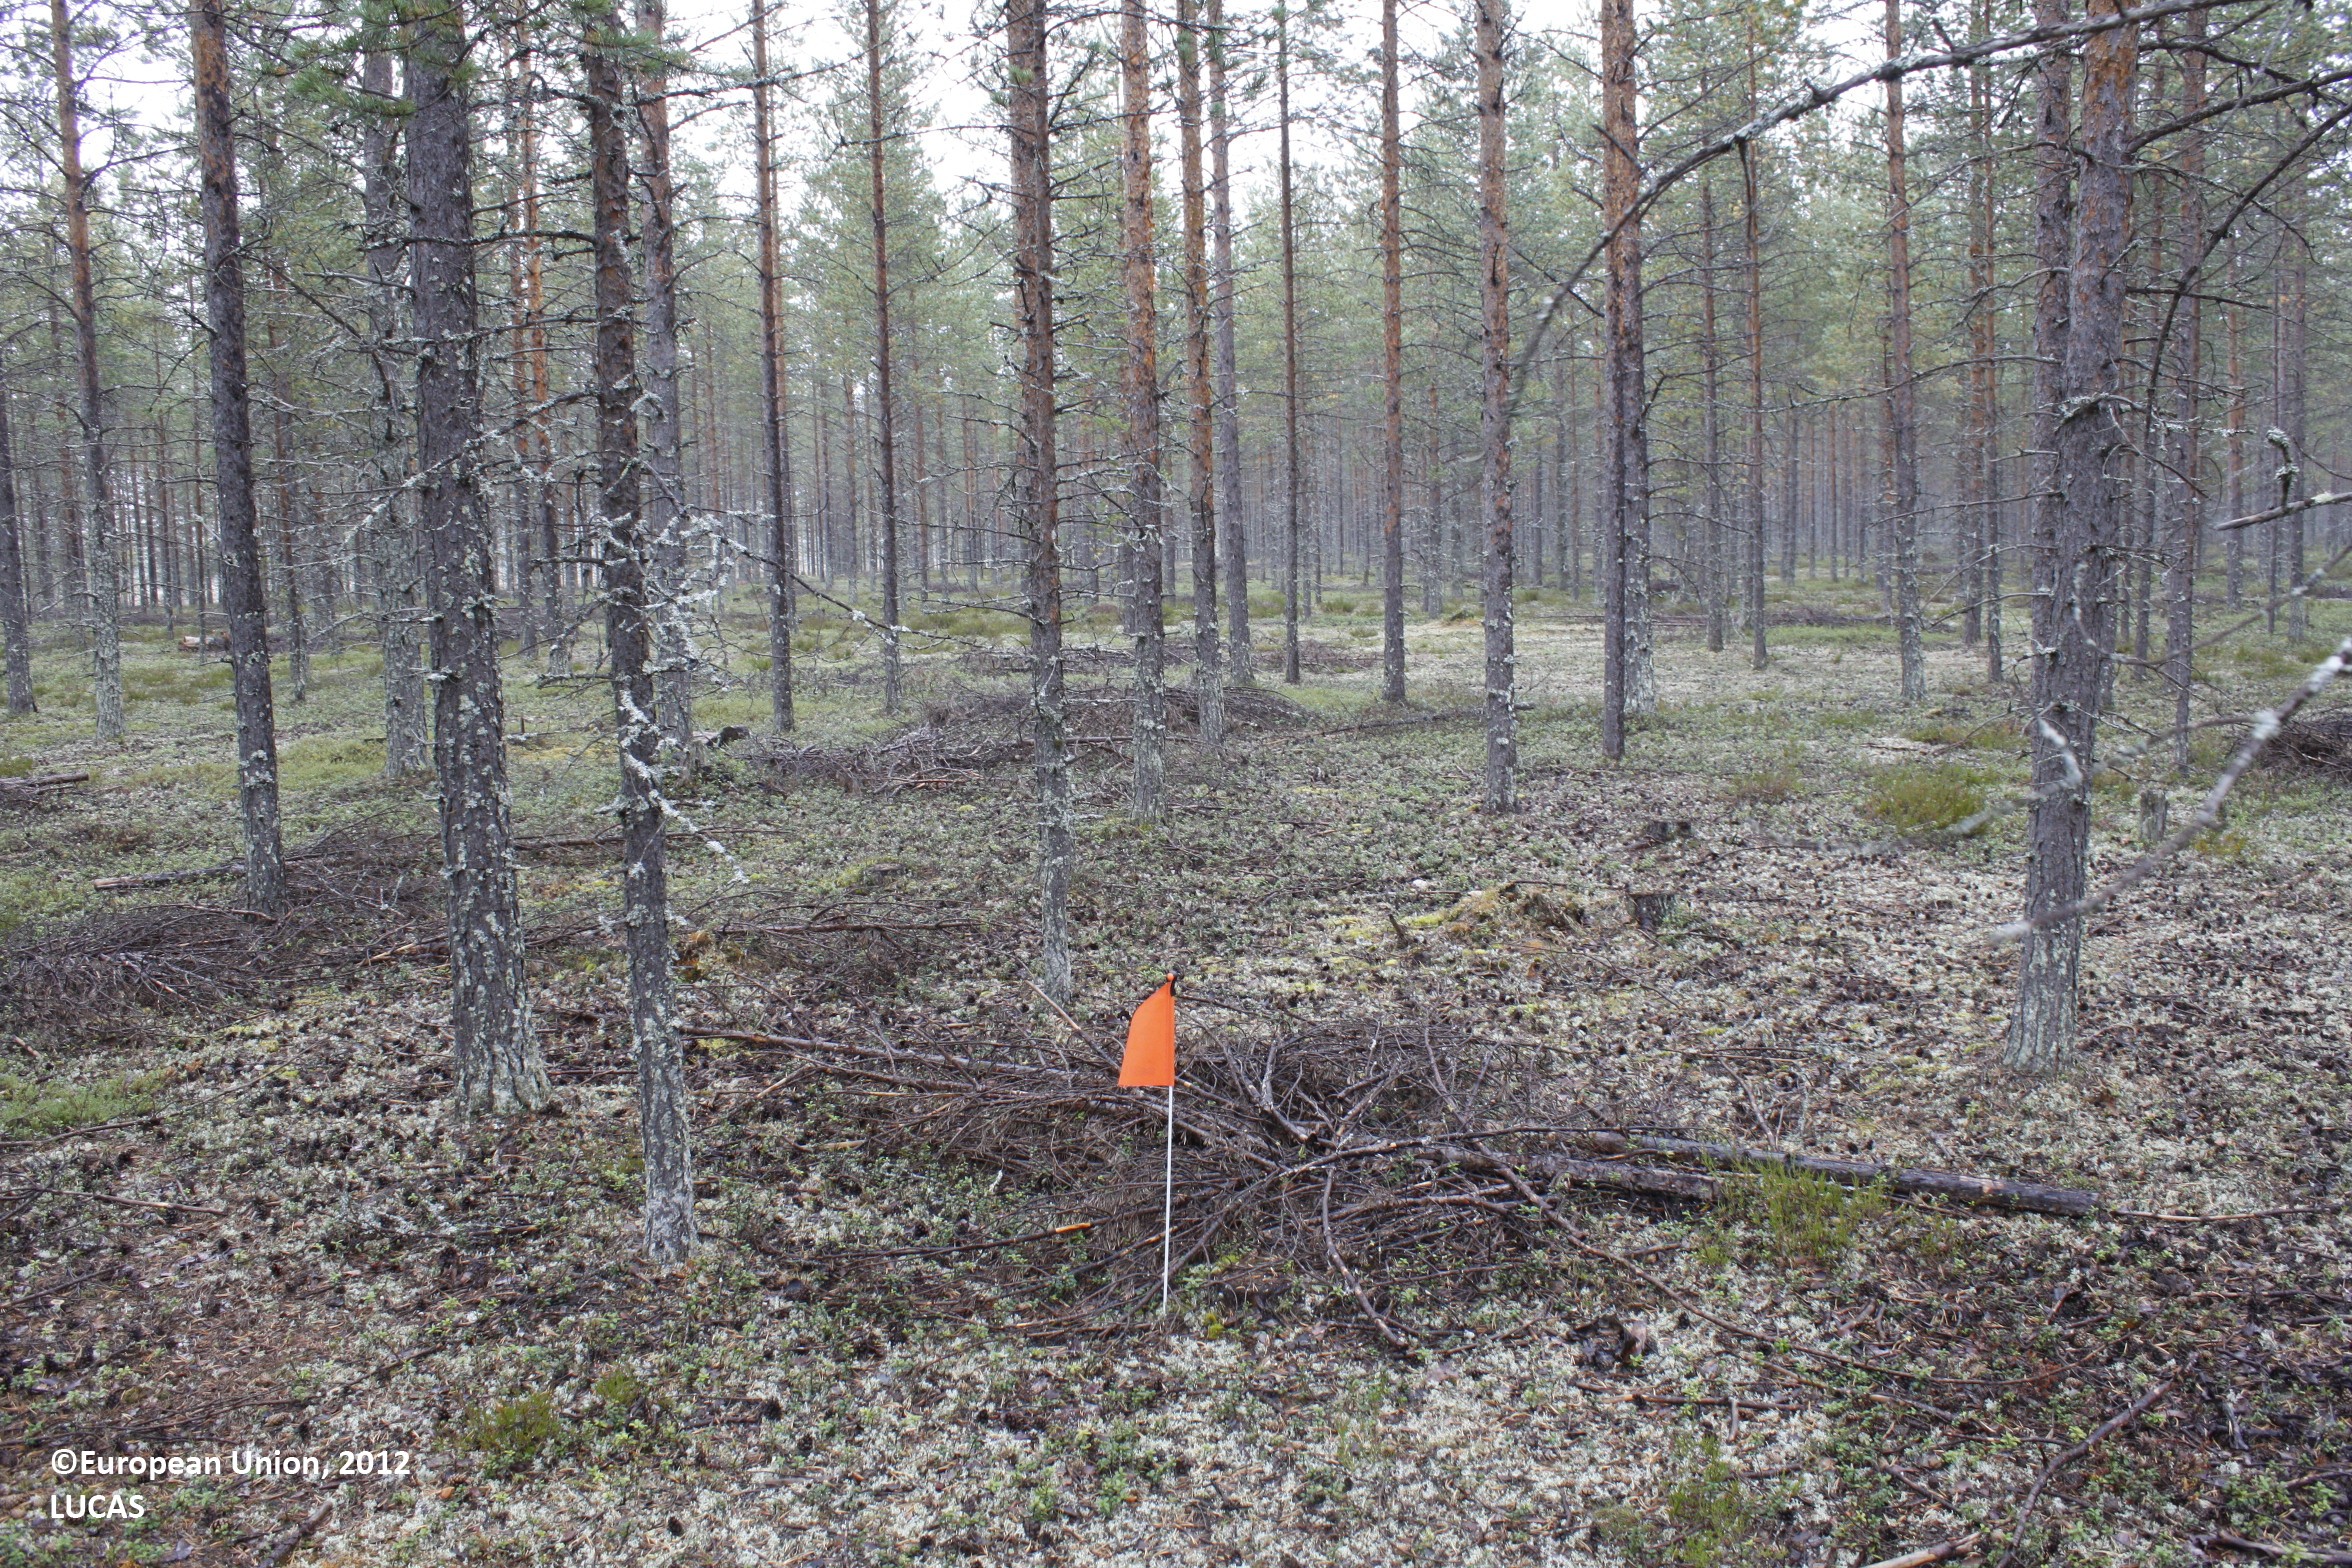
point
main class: Woodland
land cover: Pine dominated coniferous woodland
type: mire and swamp forests
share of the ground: 25 - 50 %
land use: Forestry
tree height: > 5 m
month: September
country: FI
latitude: 65.3928
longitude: 26.9237
